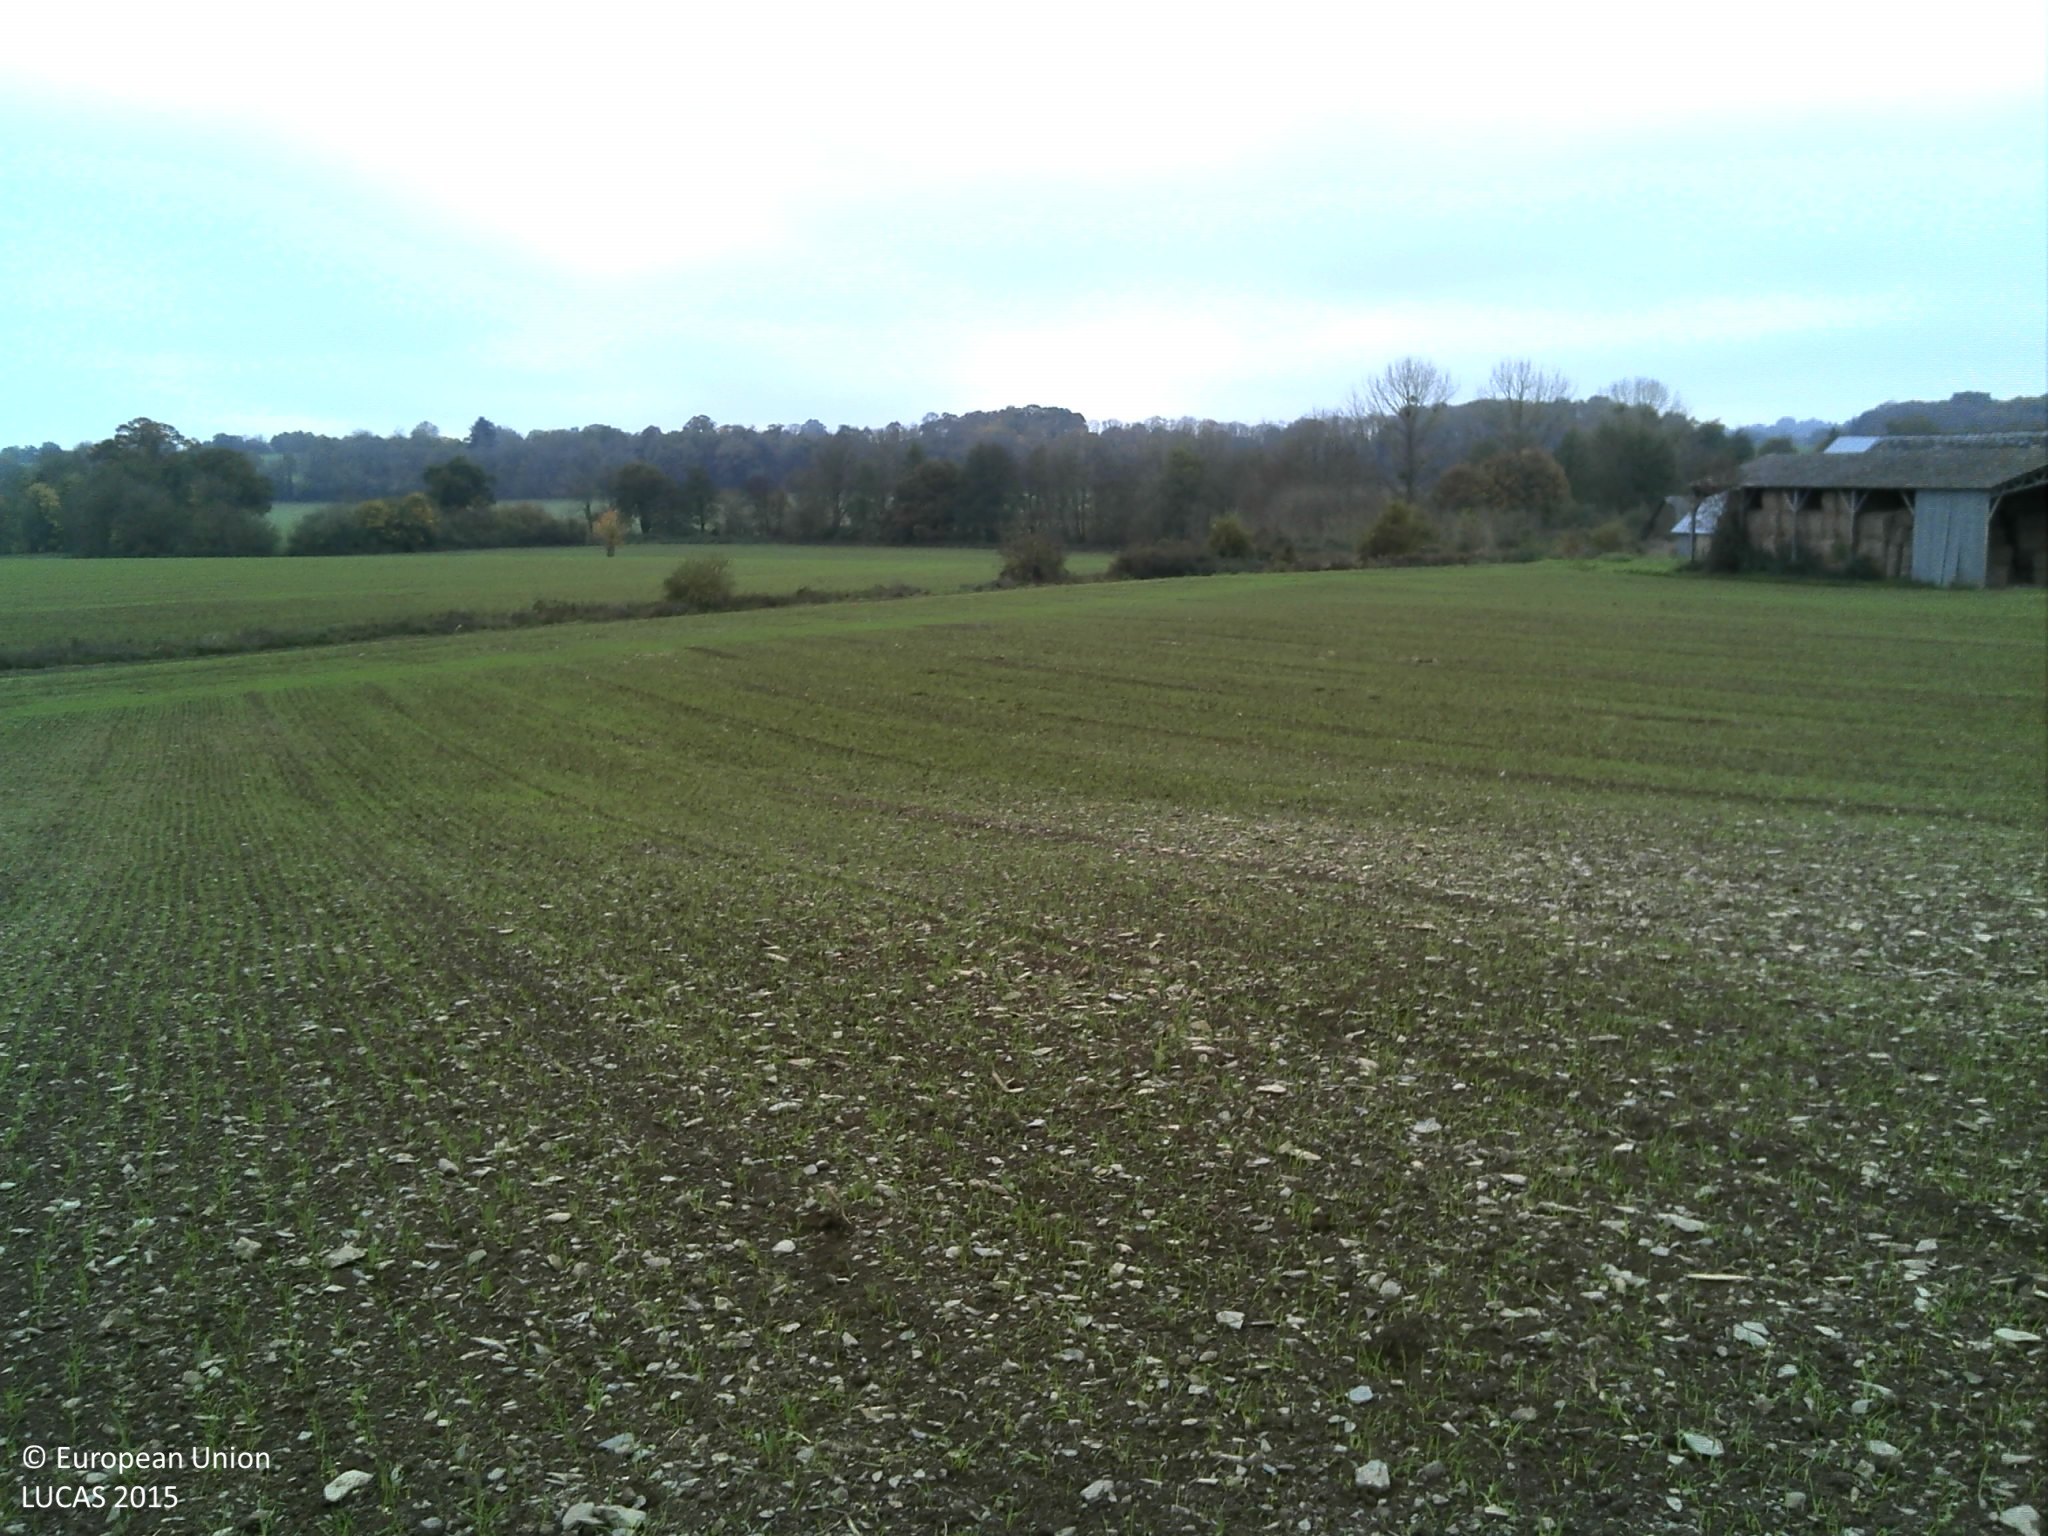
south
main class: Cropland
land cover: Common wheat
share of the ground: < 10 %
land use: Agriculture (excluding fallow land and kitchen gardens)
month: November
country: FR
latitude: 47.6157
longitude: -1.3636
